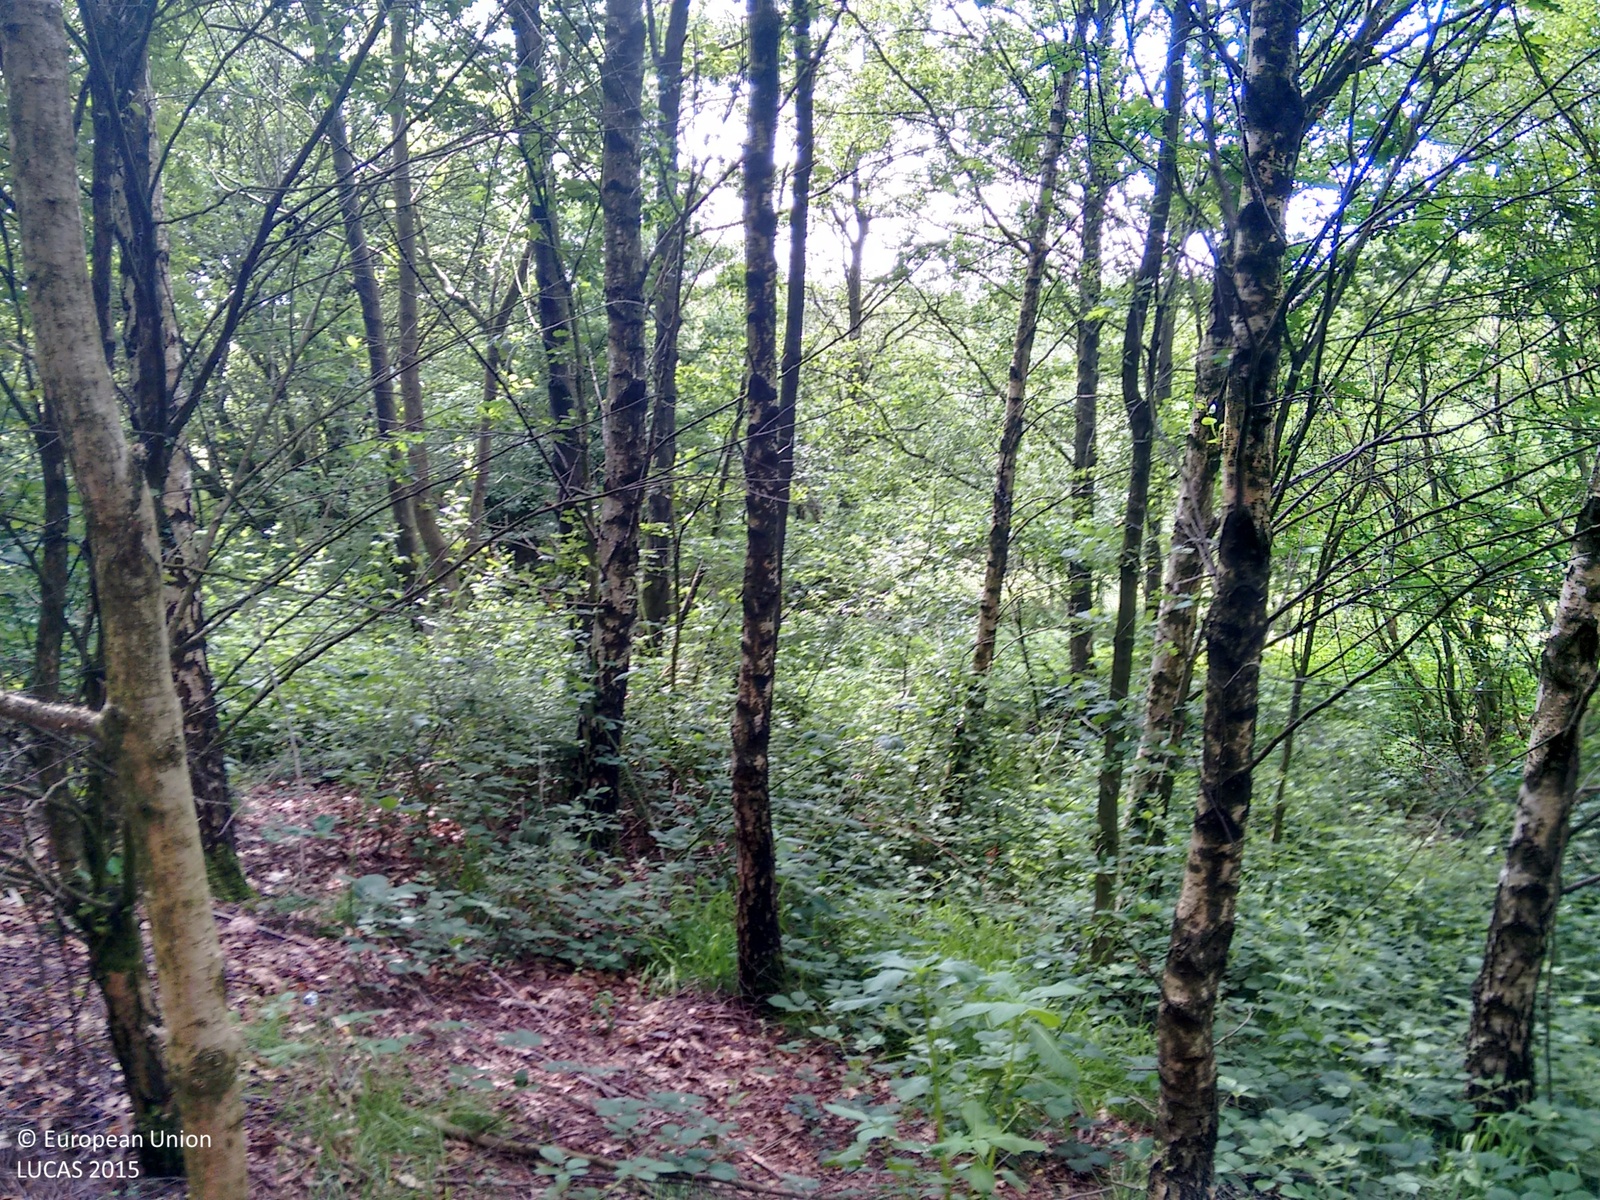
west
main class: Woodland
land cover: Broadleaved woodland
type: mesophytic deciduous forest
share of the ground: > 75 %
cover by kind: broadleaved forest trees 100 %
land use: Sport
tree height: > 5 m
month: June
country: GB
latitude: 53.4984
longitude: -2.1345
